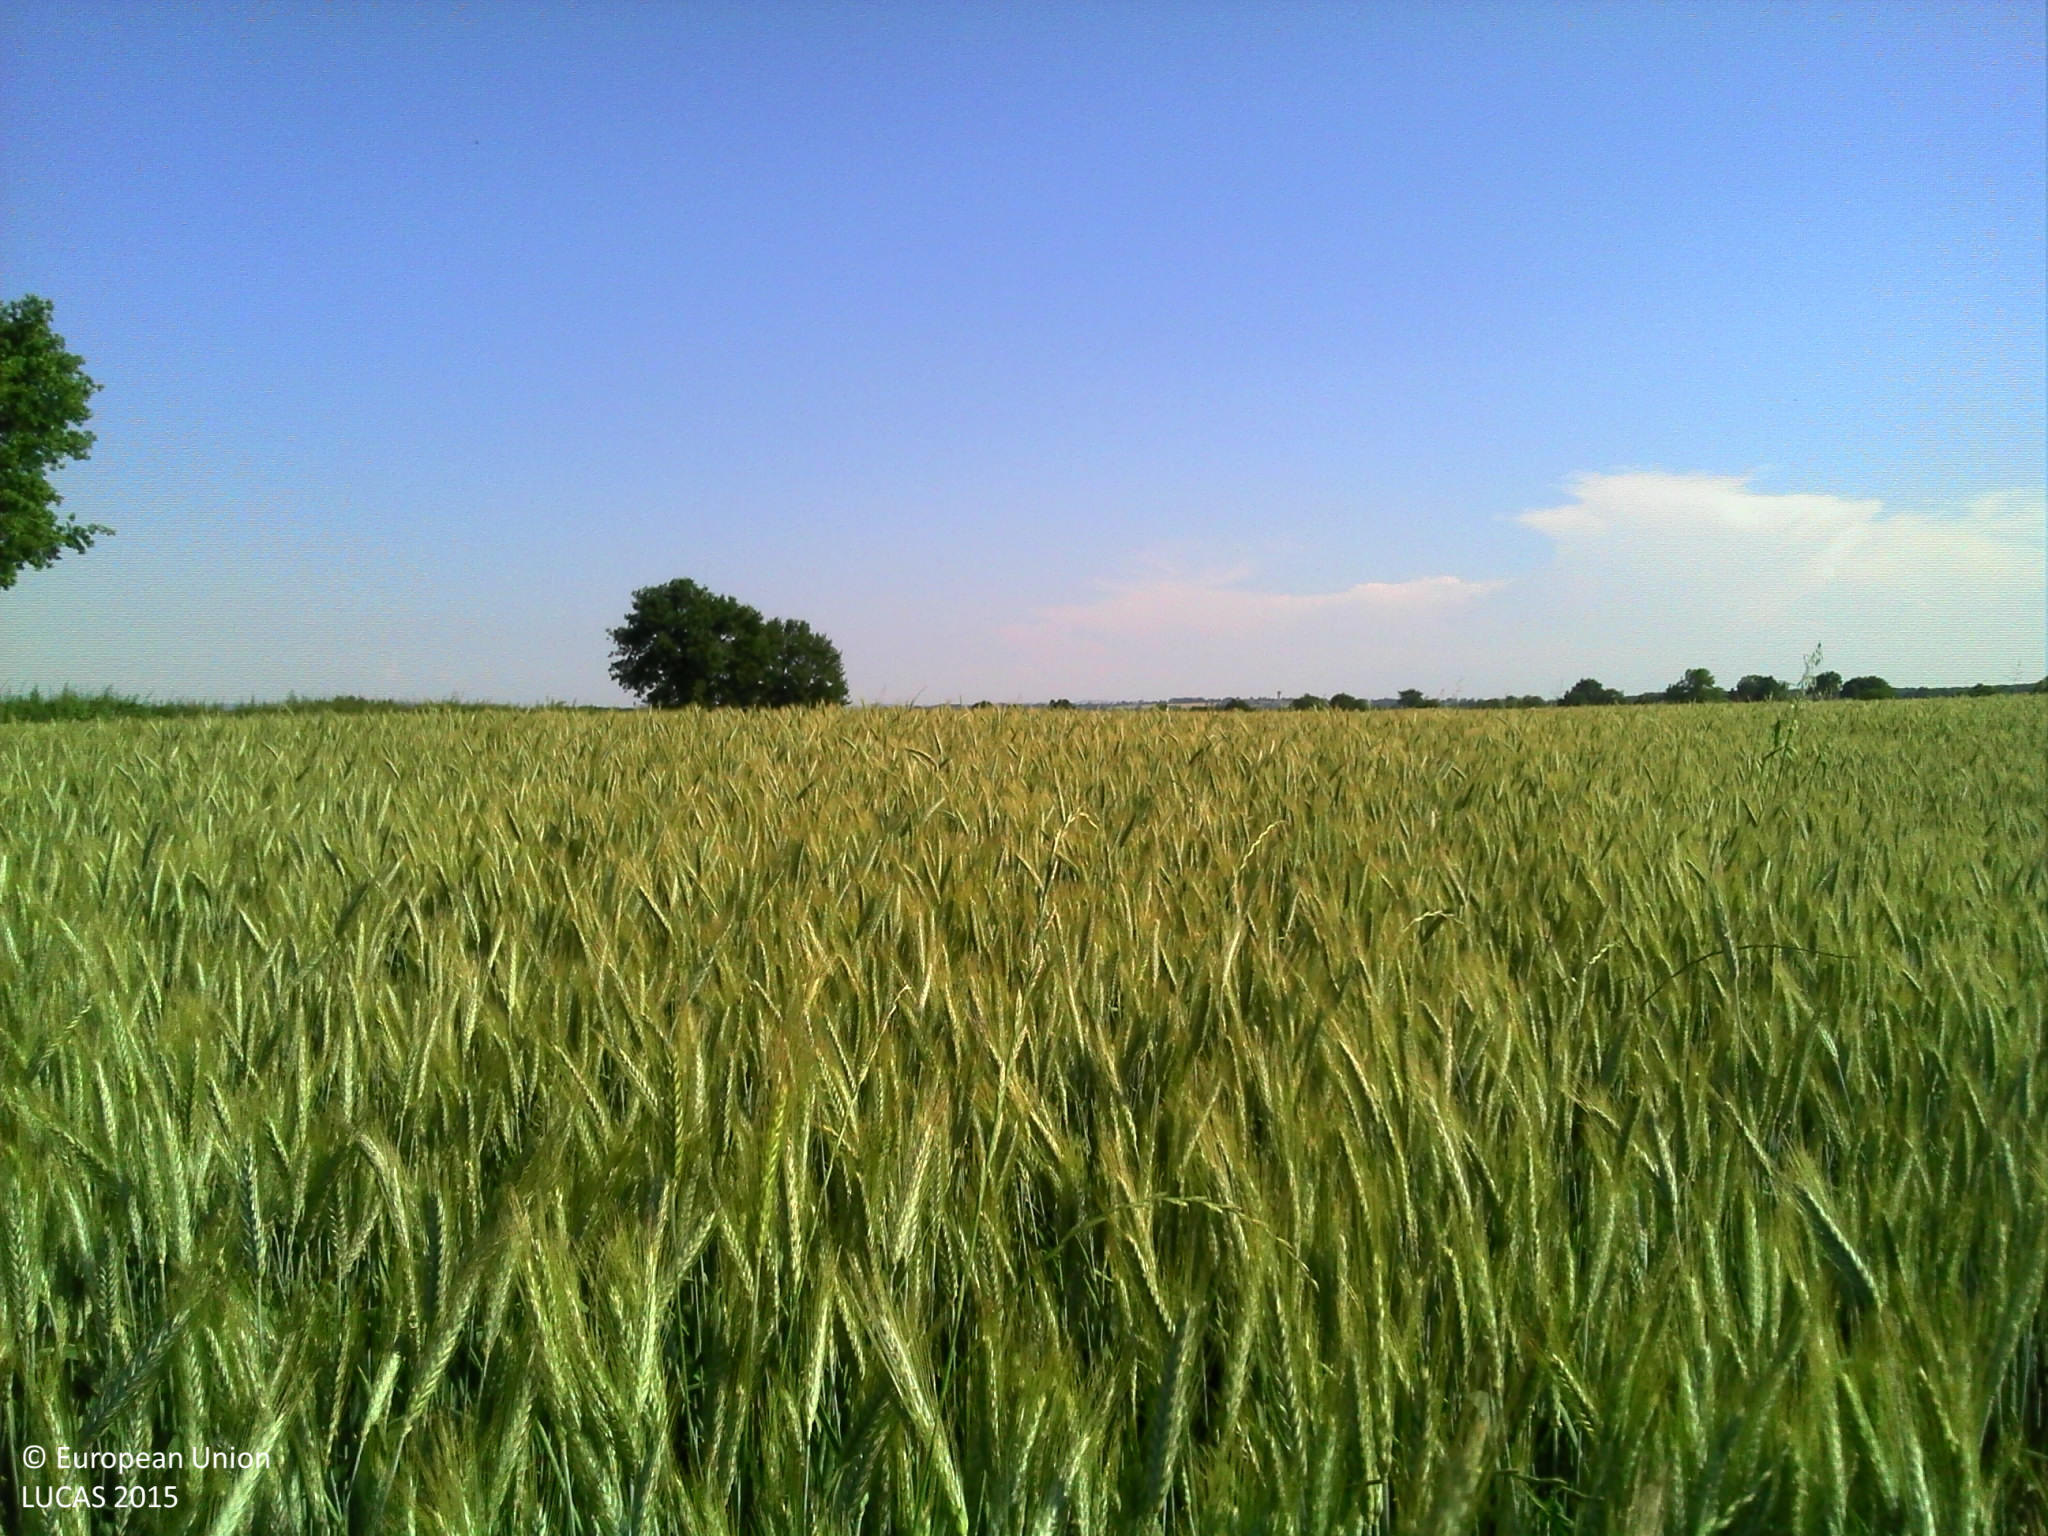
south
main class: Cropland
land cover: Common wheat
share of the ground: > 75 %
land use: Agriculture (excluding fallow land and kitchen gardens)
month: June
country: FR
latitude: 46.4268
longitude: 2.6960
